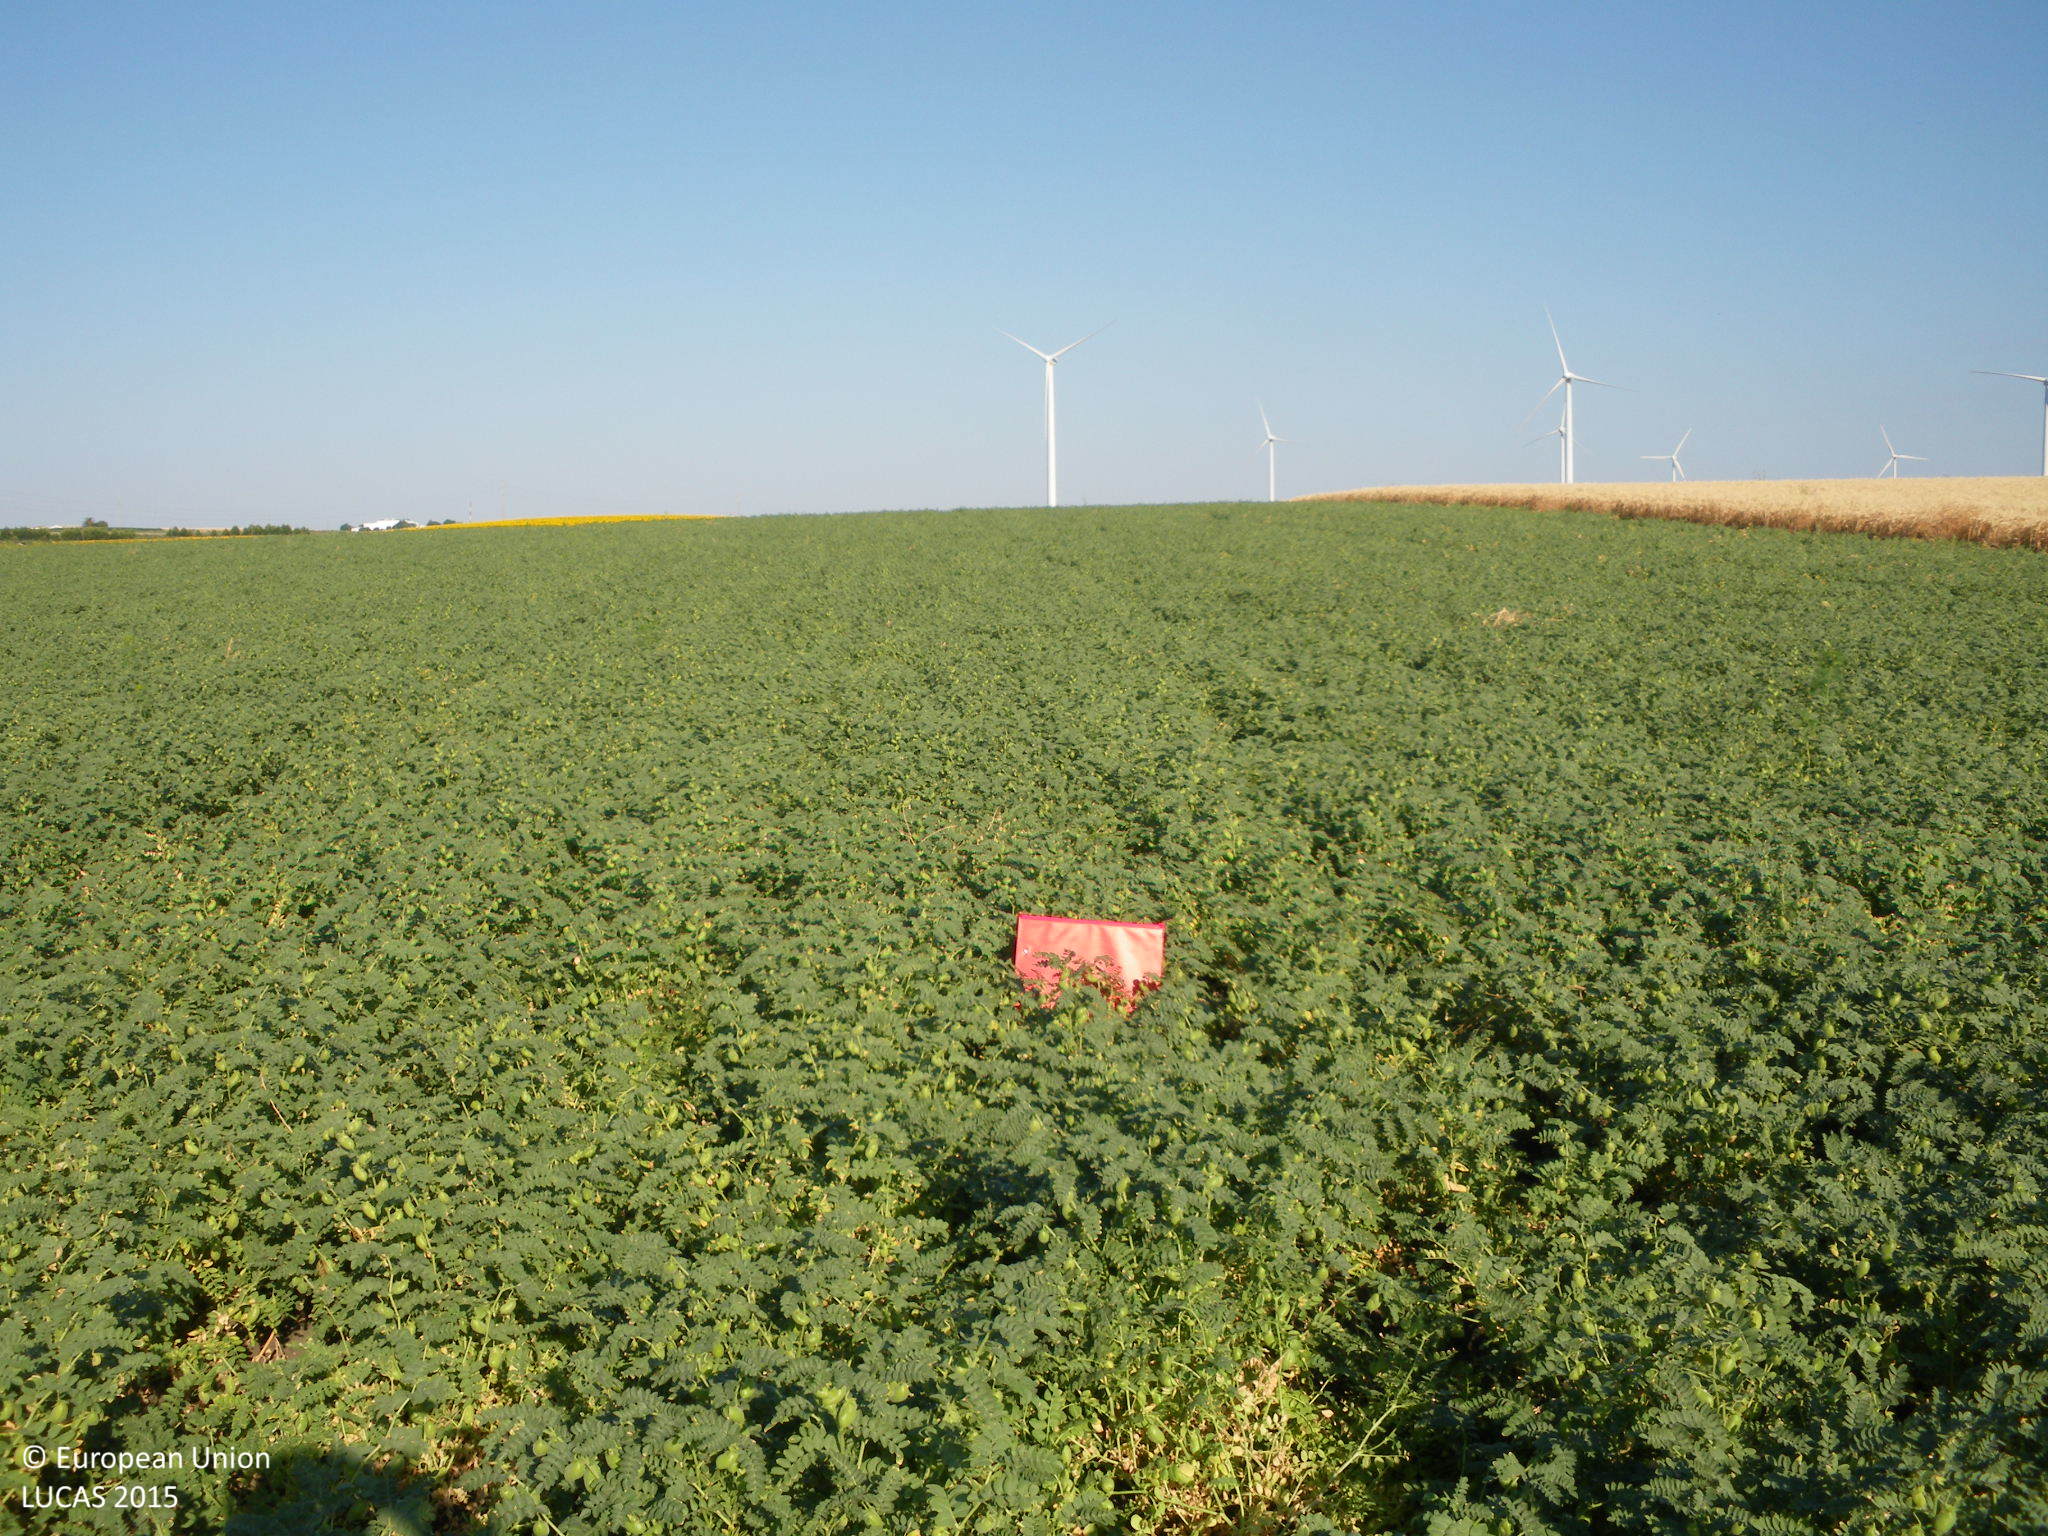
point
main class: Cropland
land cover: Dry pulses
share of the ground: > 75 %
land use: Agriculture (excluding fallow land and kitchen gardens)
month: May
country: ES
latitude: 36.7252
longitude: -6.2617
